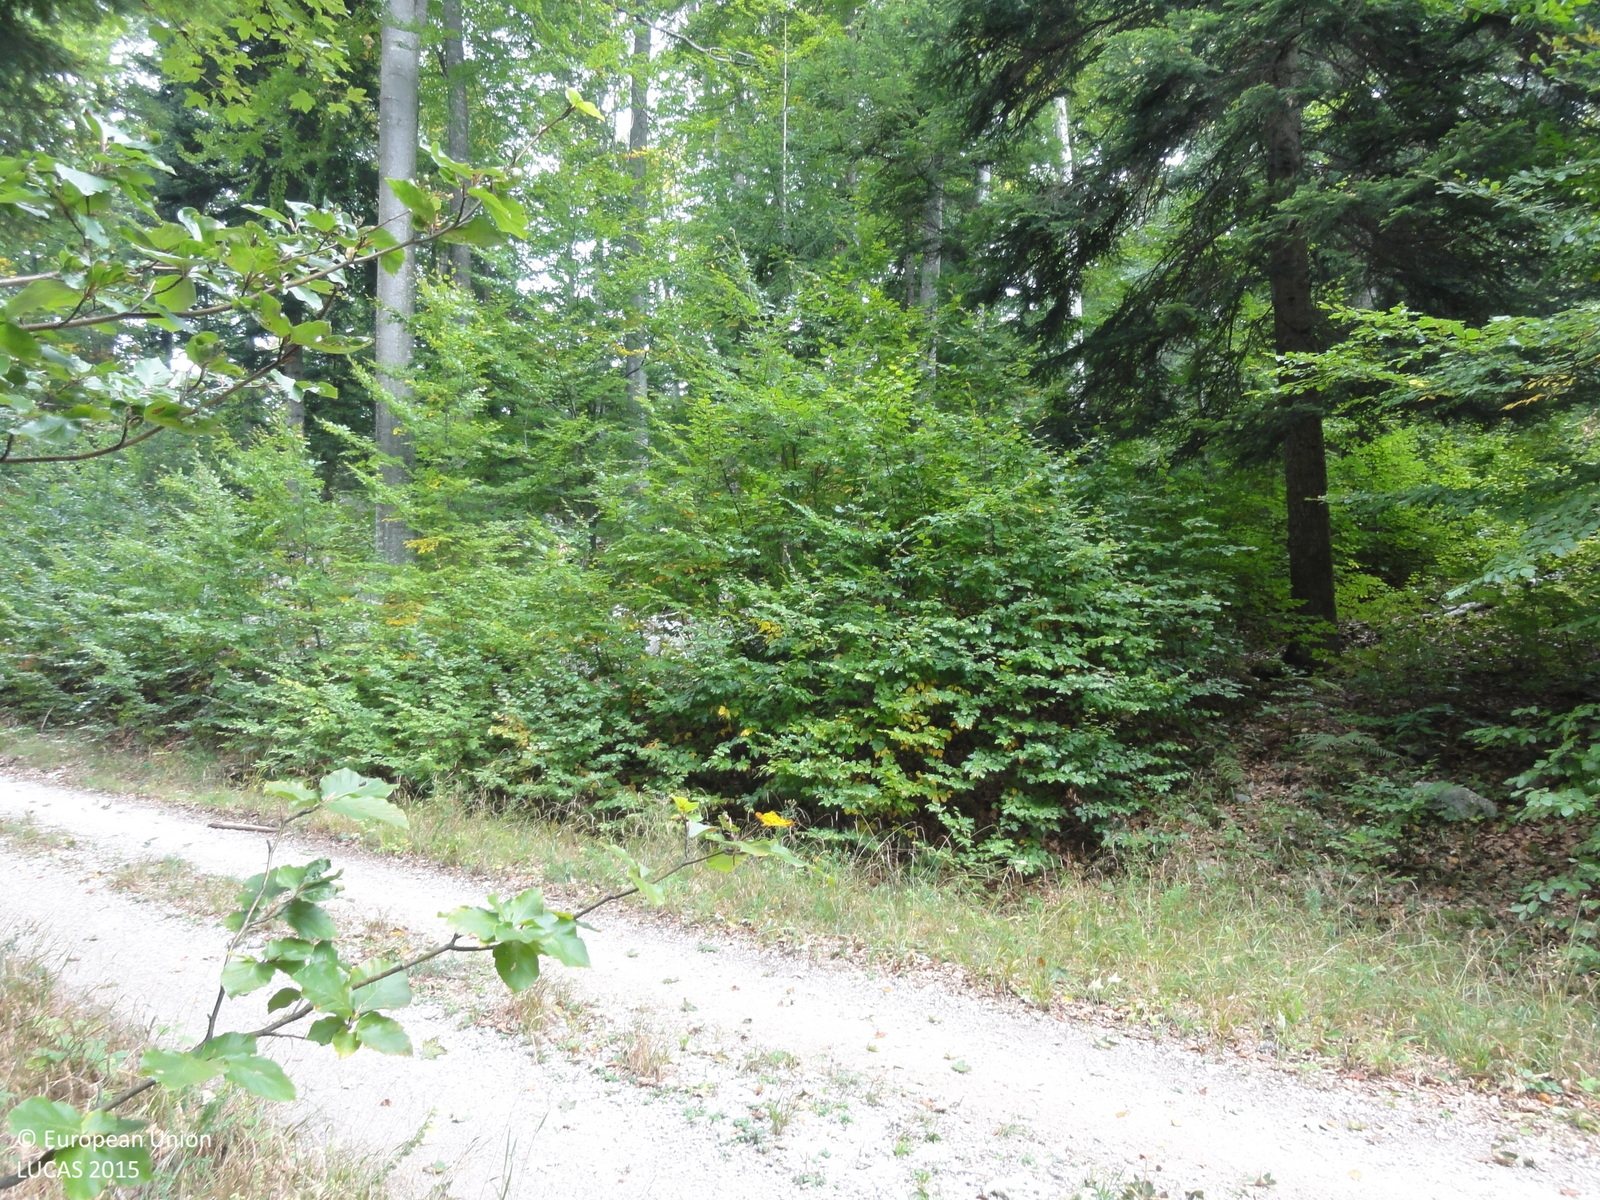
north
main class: Woodland
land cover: Spruce dominated mixed woodland
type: mountainous beech forest
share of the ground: > 75 %
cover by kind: broadleaved forest trees 45 %, coniferous forest trees 40 %, unconsolidated bare surface 10 %, herbaceous plants 5 %
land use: Forestry
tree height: > 5 m
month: September
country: SI
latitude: 45.6189
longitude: 15.0361
